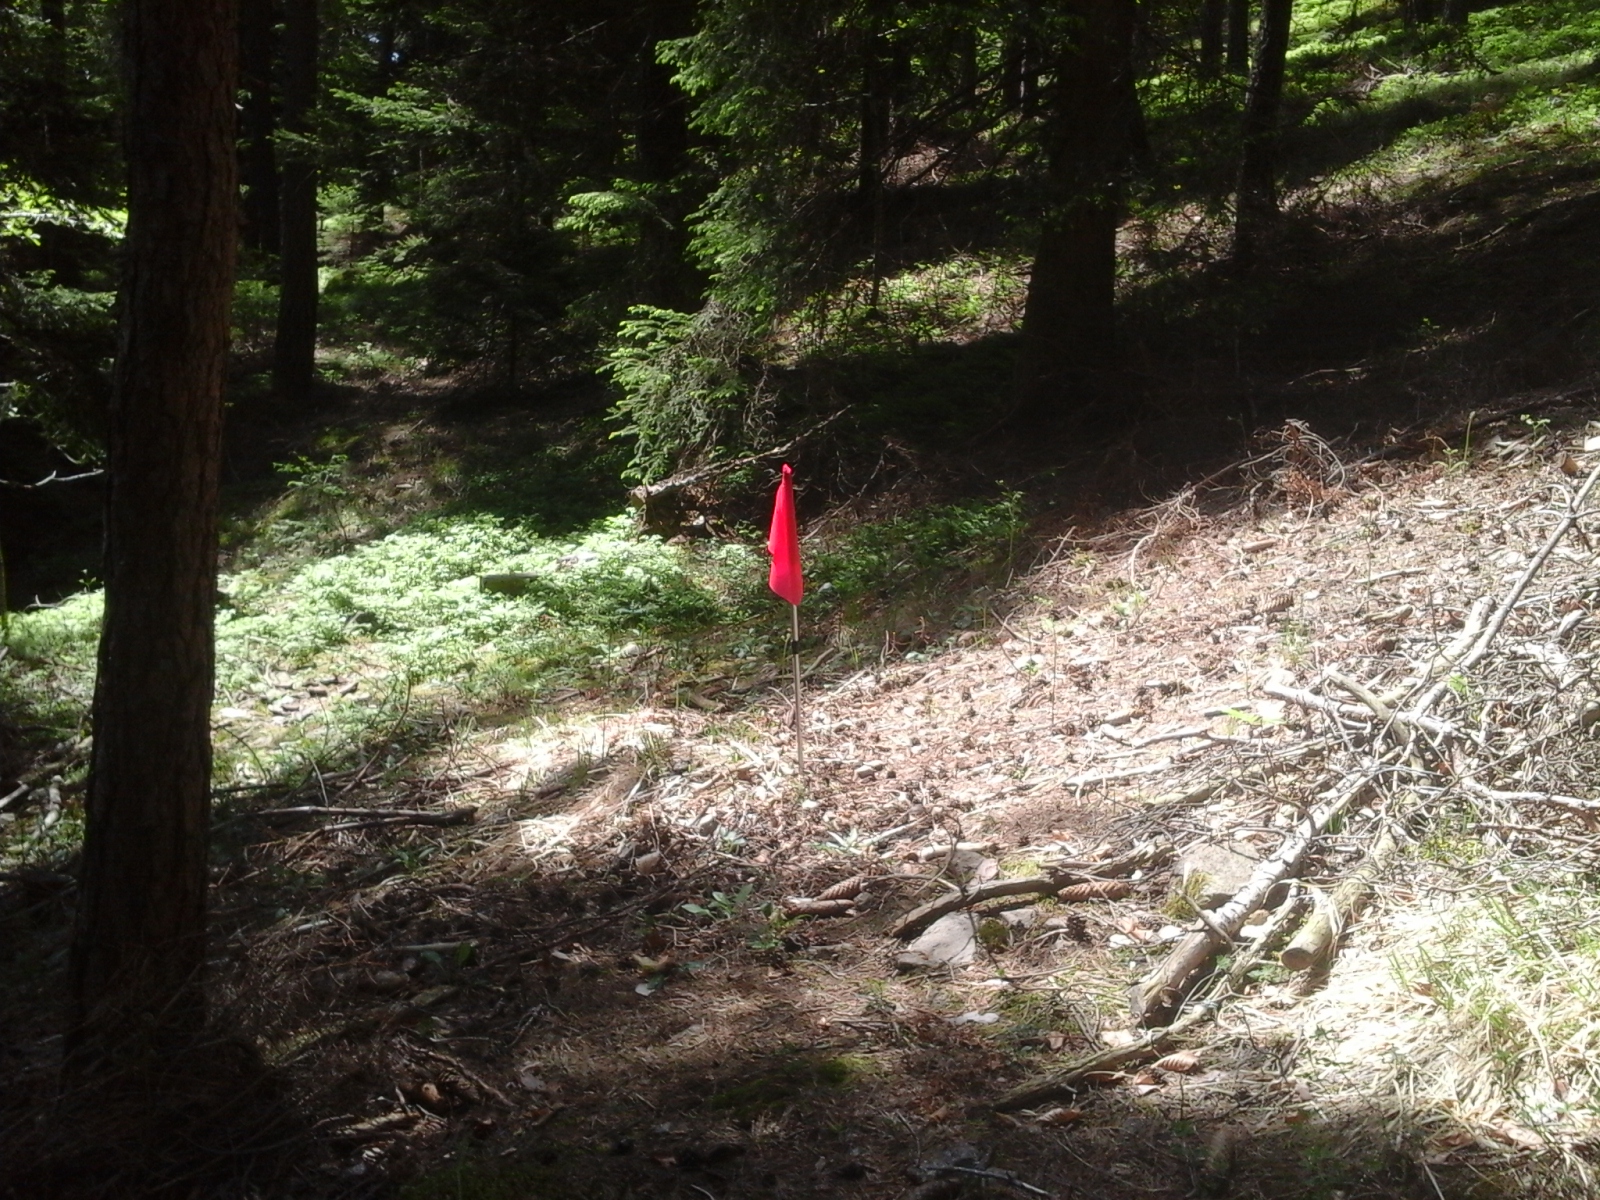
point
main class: Woodland
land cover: Pine dominated coniferous woodland
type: alpine coniferous forest
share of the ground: > 75 %
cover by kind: coniferous forest trees 90 %, broadleaved forest trees 5 %, herbaceous plants 5 %
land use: Forestry
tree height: > 5 m
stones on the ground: 10 - 25 %
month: May
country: IT
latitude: 46.1457
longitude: 11.2541
